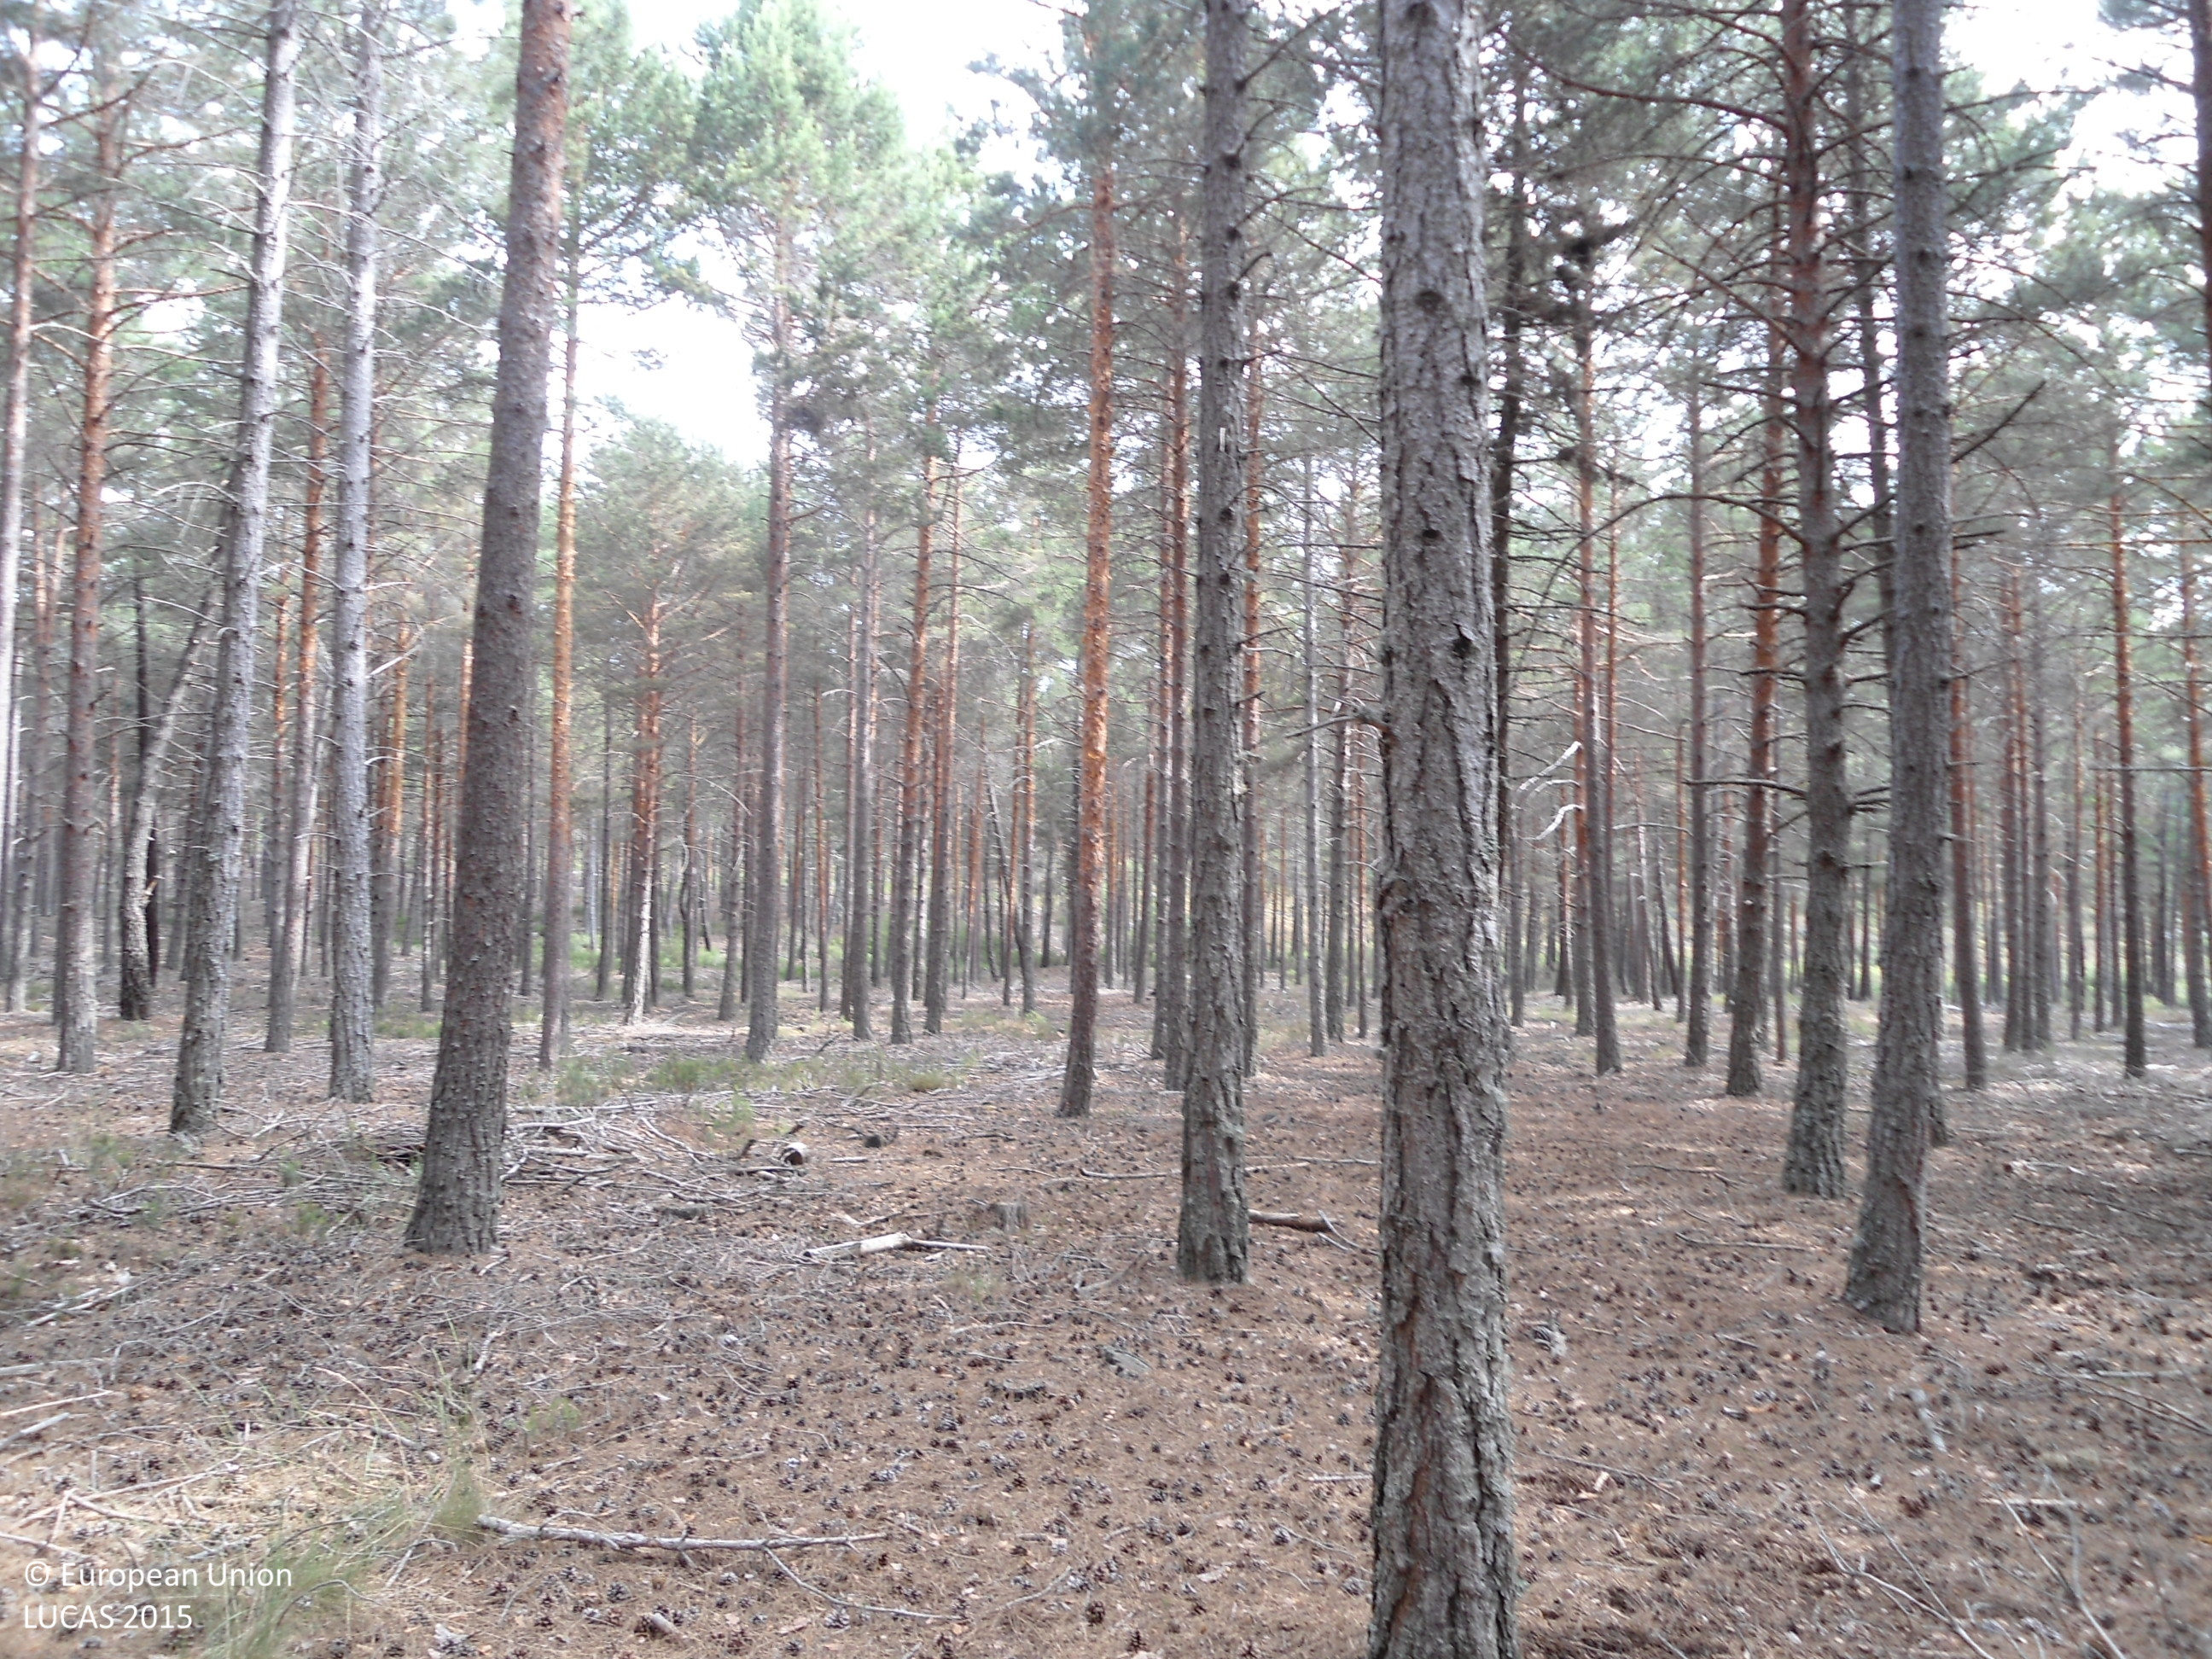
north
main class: Woodland
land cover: Pine dominated coniferous woodland
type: coniferous forest of the mediterranean region
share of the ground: > 75 %
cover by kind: coniferous forest trees 100 %
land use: Forestry
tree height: > 5 m
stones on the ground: < 10 %
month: June
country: ES
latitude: 41.9924
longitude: -6.5892
